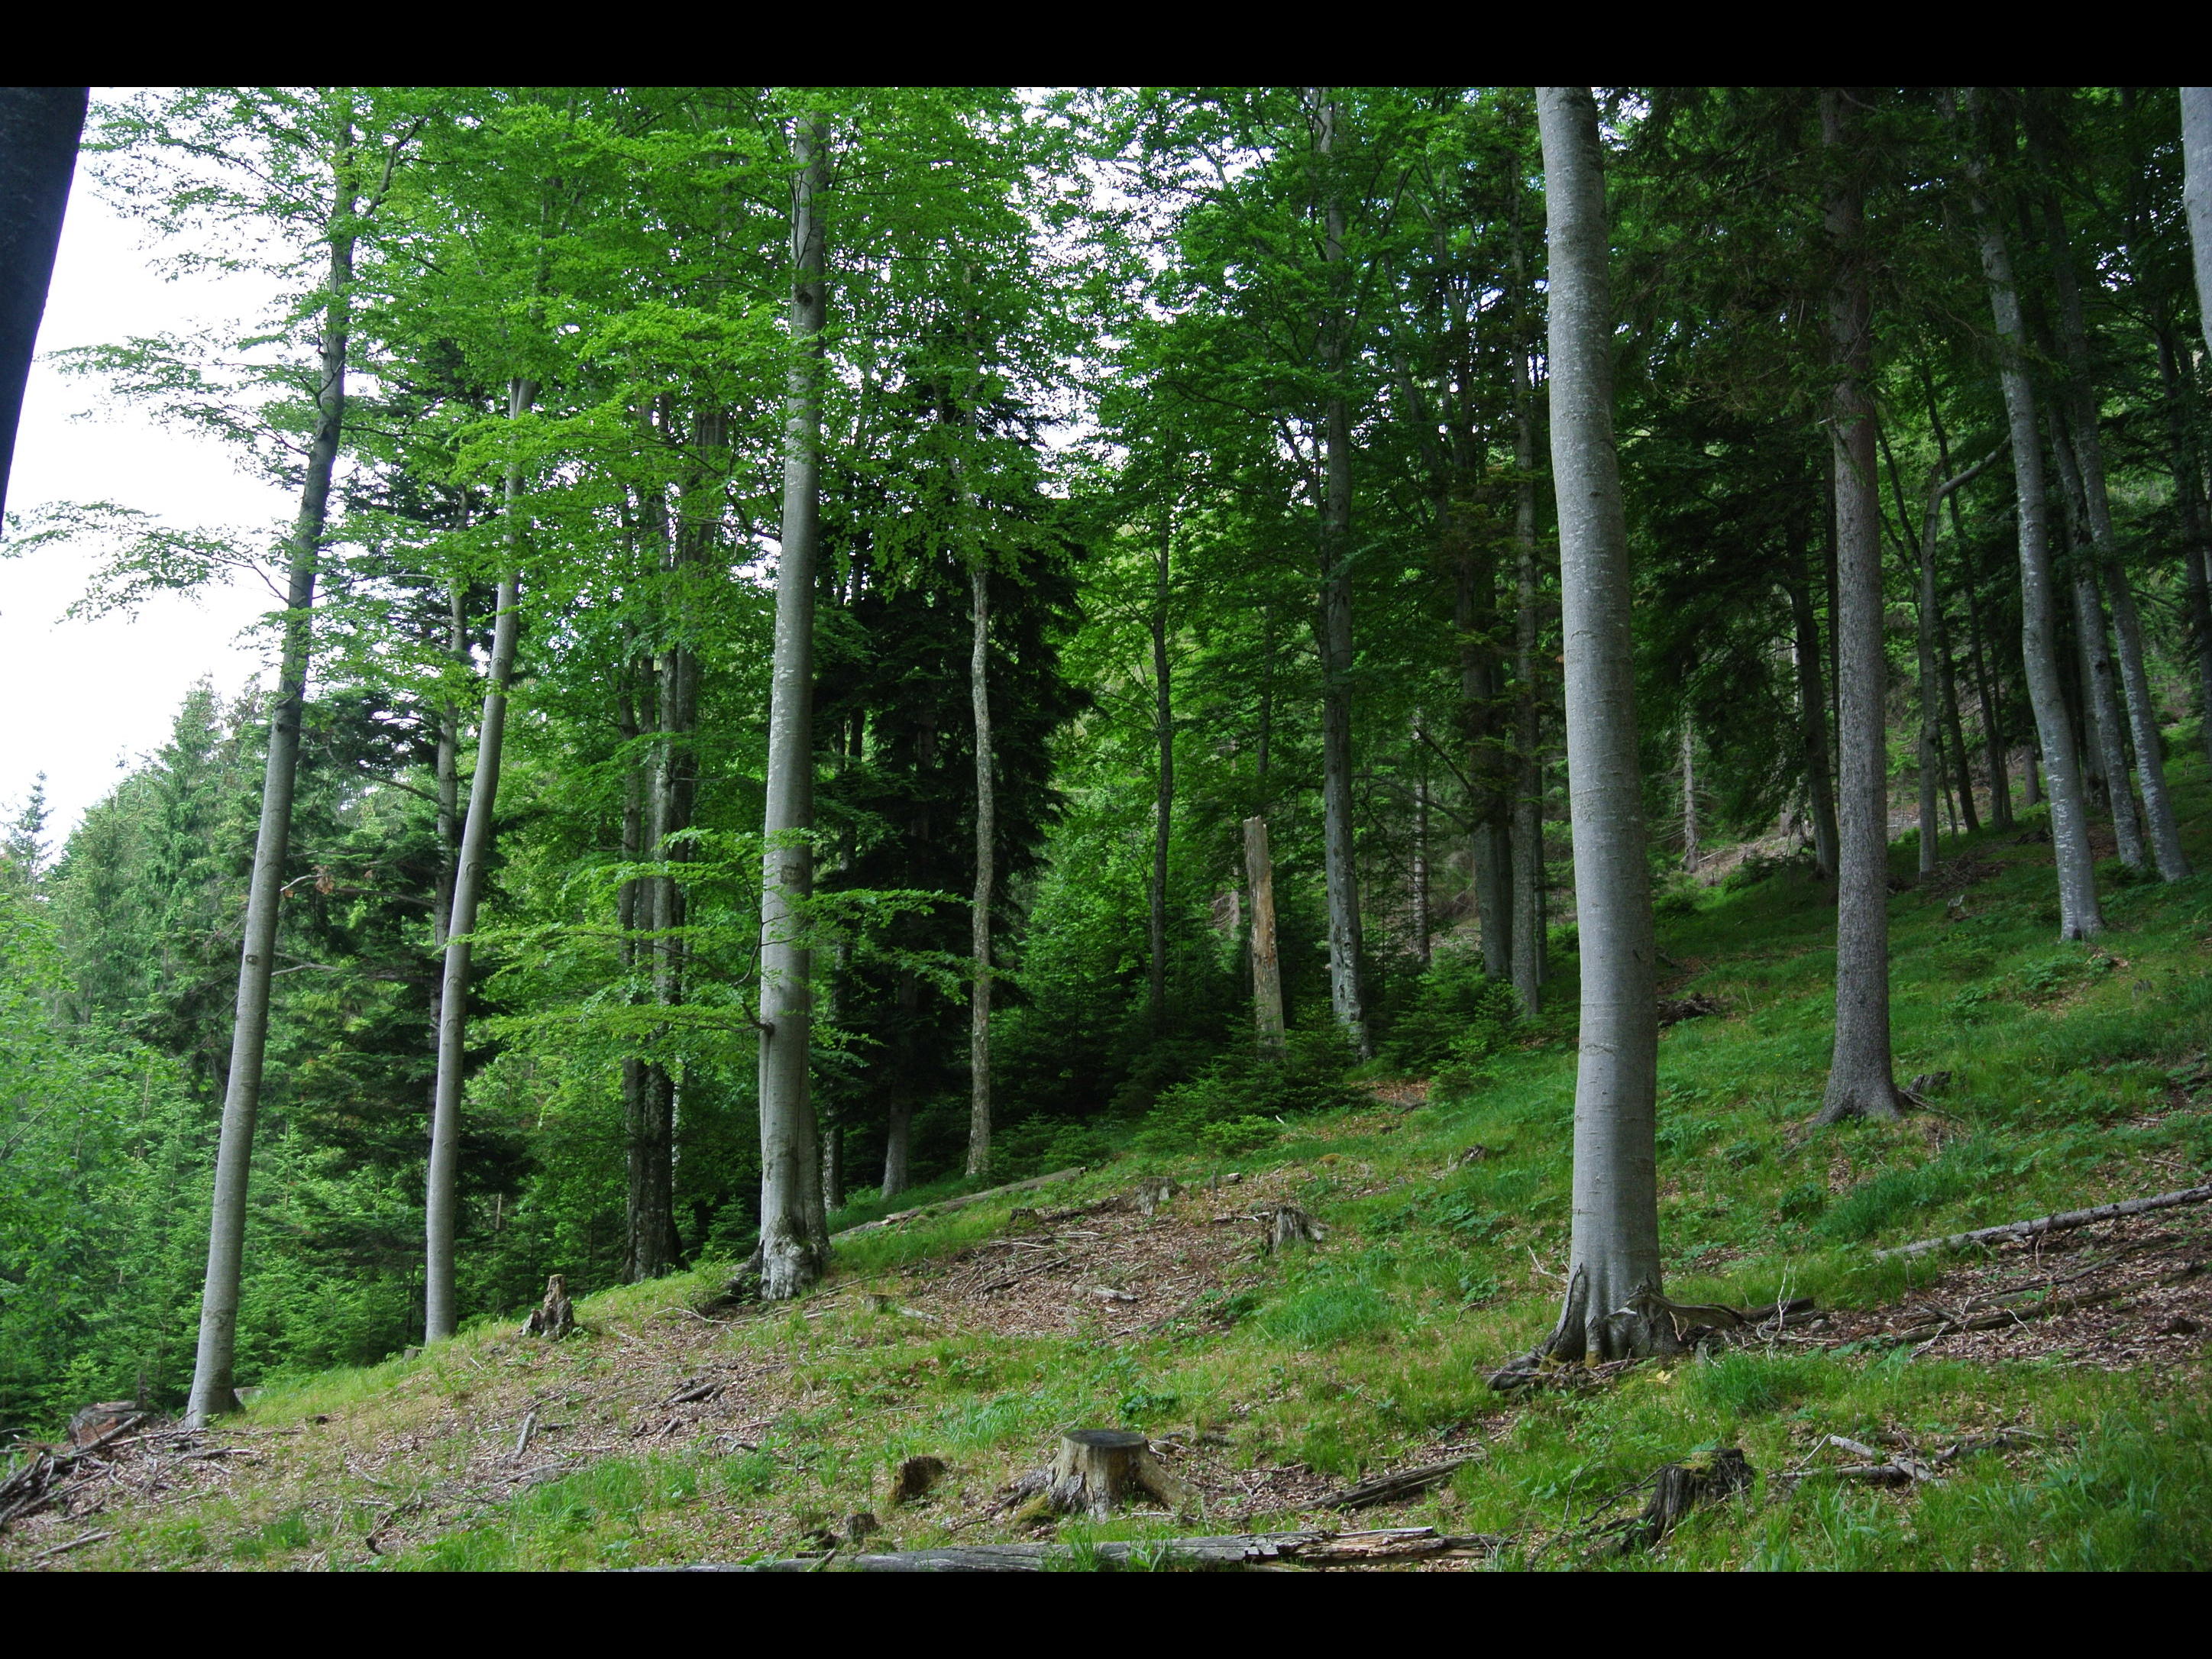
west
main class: Woodland
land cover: Other mixed woodland
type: hemiboreal forest and nemoral coniferous forest and mixed broadleaved-coniferous forest
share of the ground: > 75 %
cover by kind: broadleaved forest trees 50 %, coniferous forest trees 45 %, herbaceous plants 5 %
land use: Forestry
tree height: > 5 m
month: June
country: AT
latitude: 47.9087
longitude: 15.7957
